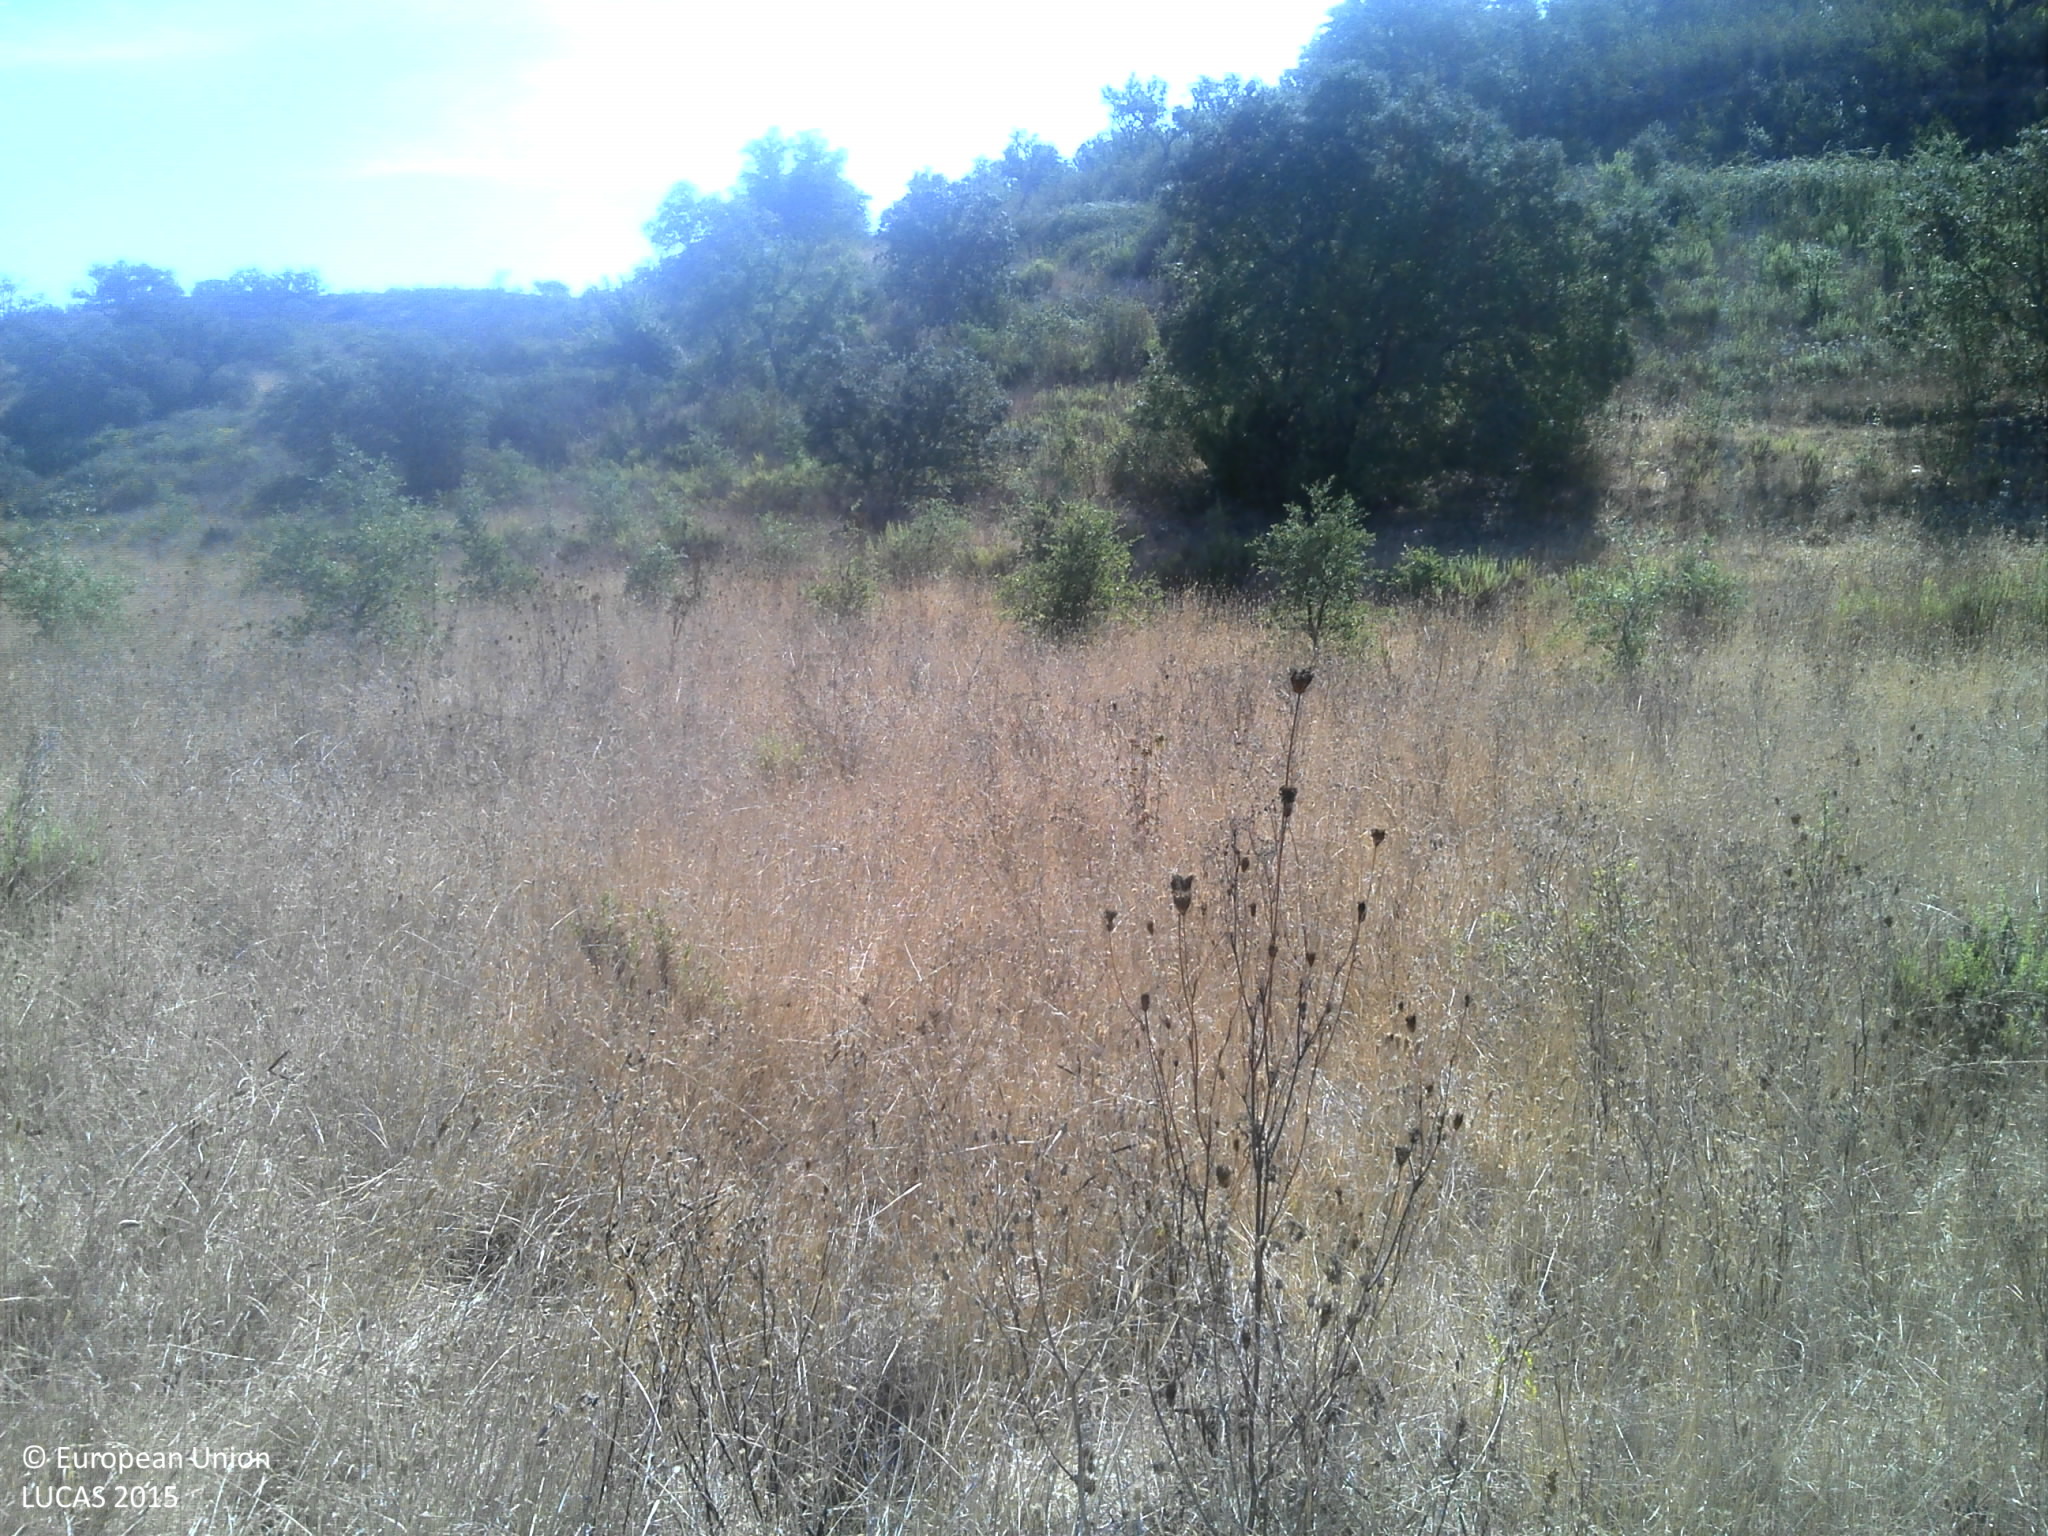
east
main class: Grassland
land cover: Grassland without tree/shrub cover
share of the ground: > 75 %
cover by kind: herbaceous plants 75 %, unconsolidated bare surface 25 %
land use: Agriculture (excluding fallow land and kitchen gardens)
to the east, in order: Grassland without tree/shrub cover; Broadleaved woodland; Shrubland without tree cover; Tracks; Shrubland without tree cover; Paved roads, cycling and walking lanes; Broadleaved woodland
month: August
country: PT
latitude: 37.5561
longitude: -8.4500
